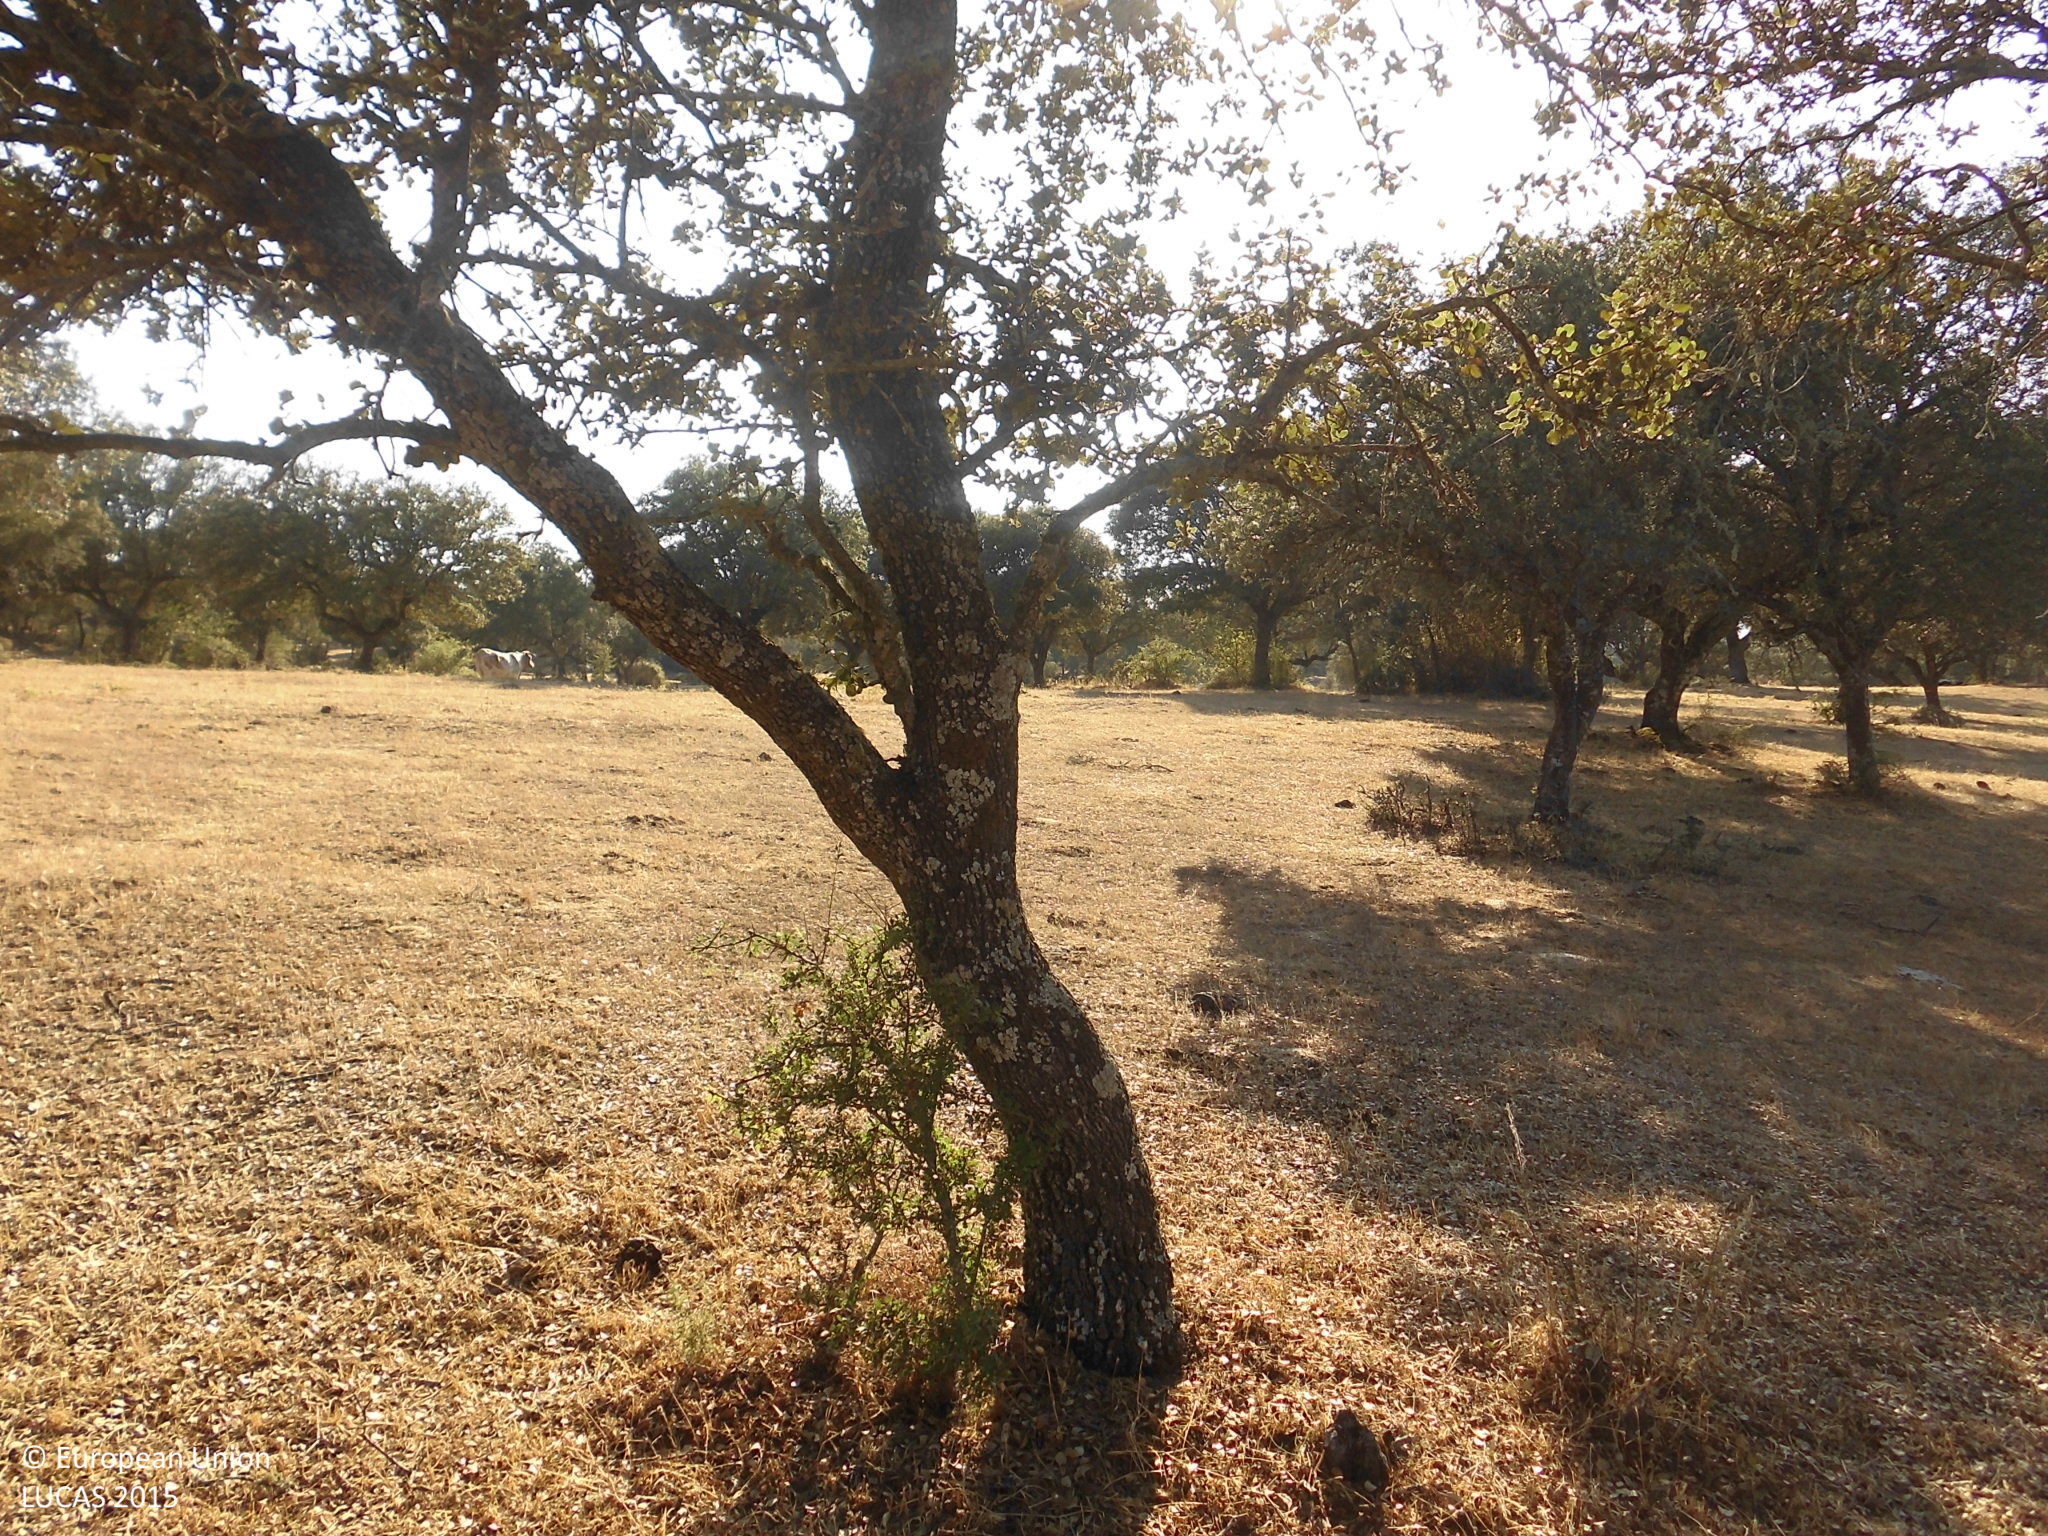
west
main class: Woodland
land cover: Broadleaved woodland
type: broadleaved evergreen forest
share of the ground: 25 - 50 %
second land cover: Grassland without tree/shrub cover
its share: > 75 %
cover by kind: herbaceous plants 70 %, broadleaved forest trees 30 %
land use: Forestry
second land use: Agriculture (excluding fallow land and kitchen gardens)
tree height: > 5 m
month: July
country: ES
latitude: 40.1532
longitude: -6.1460
